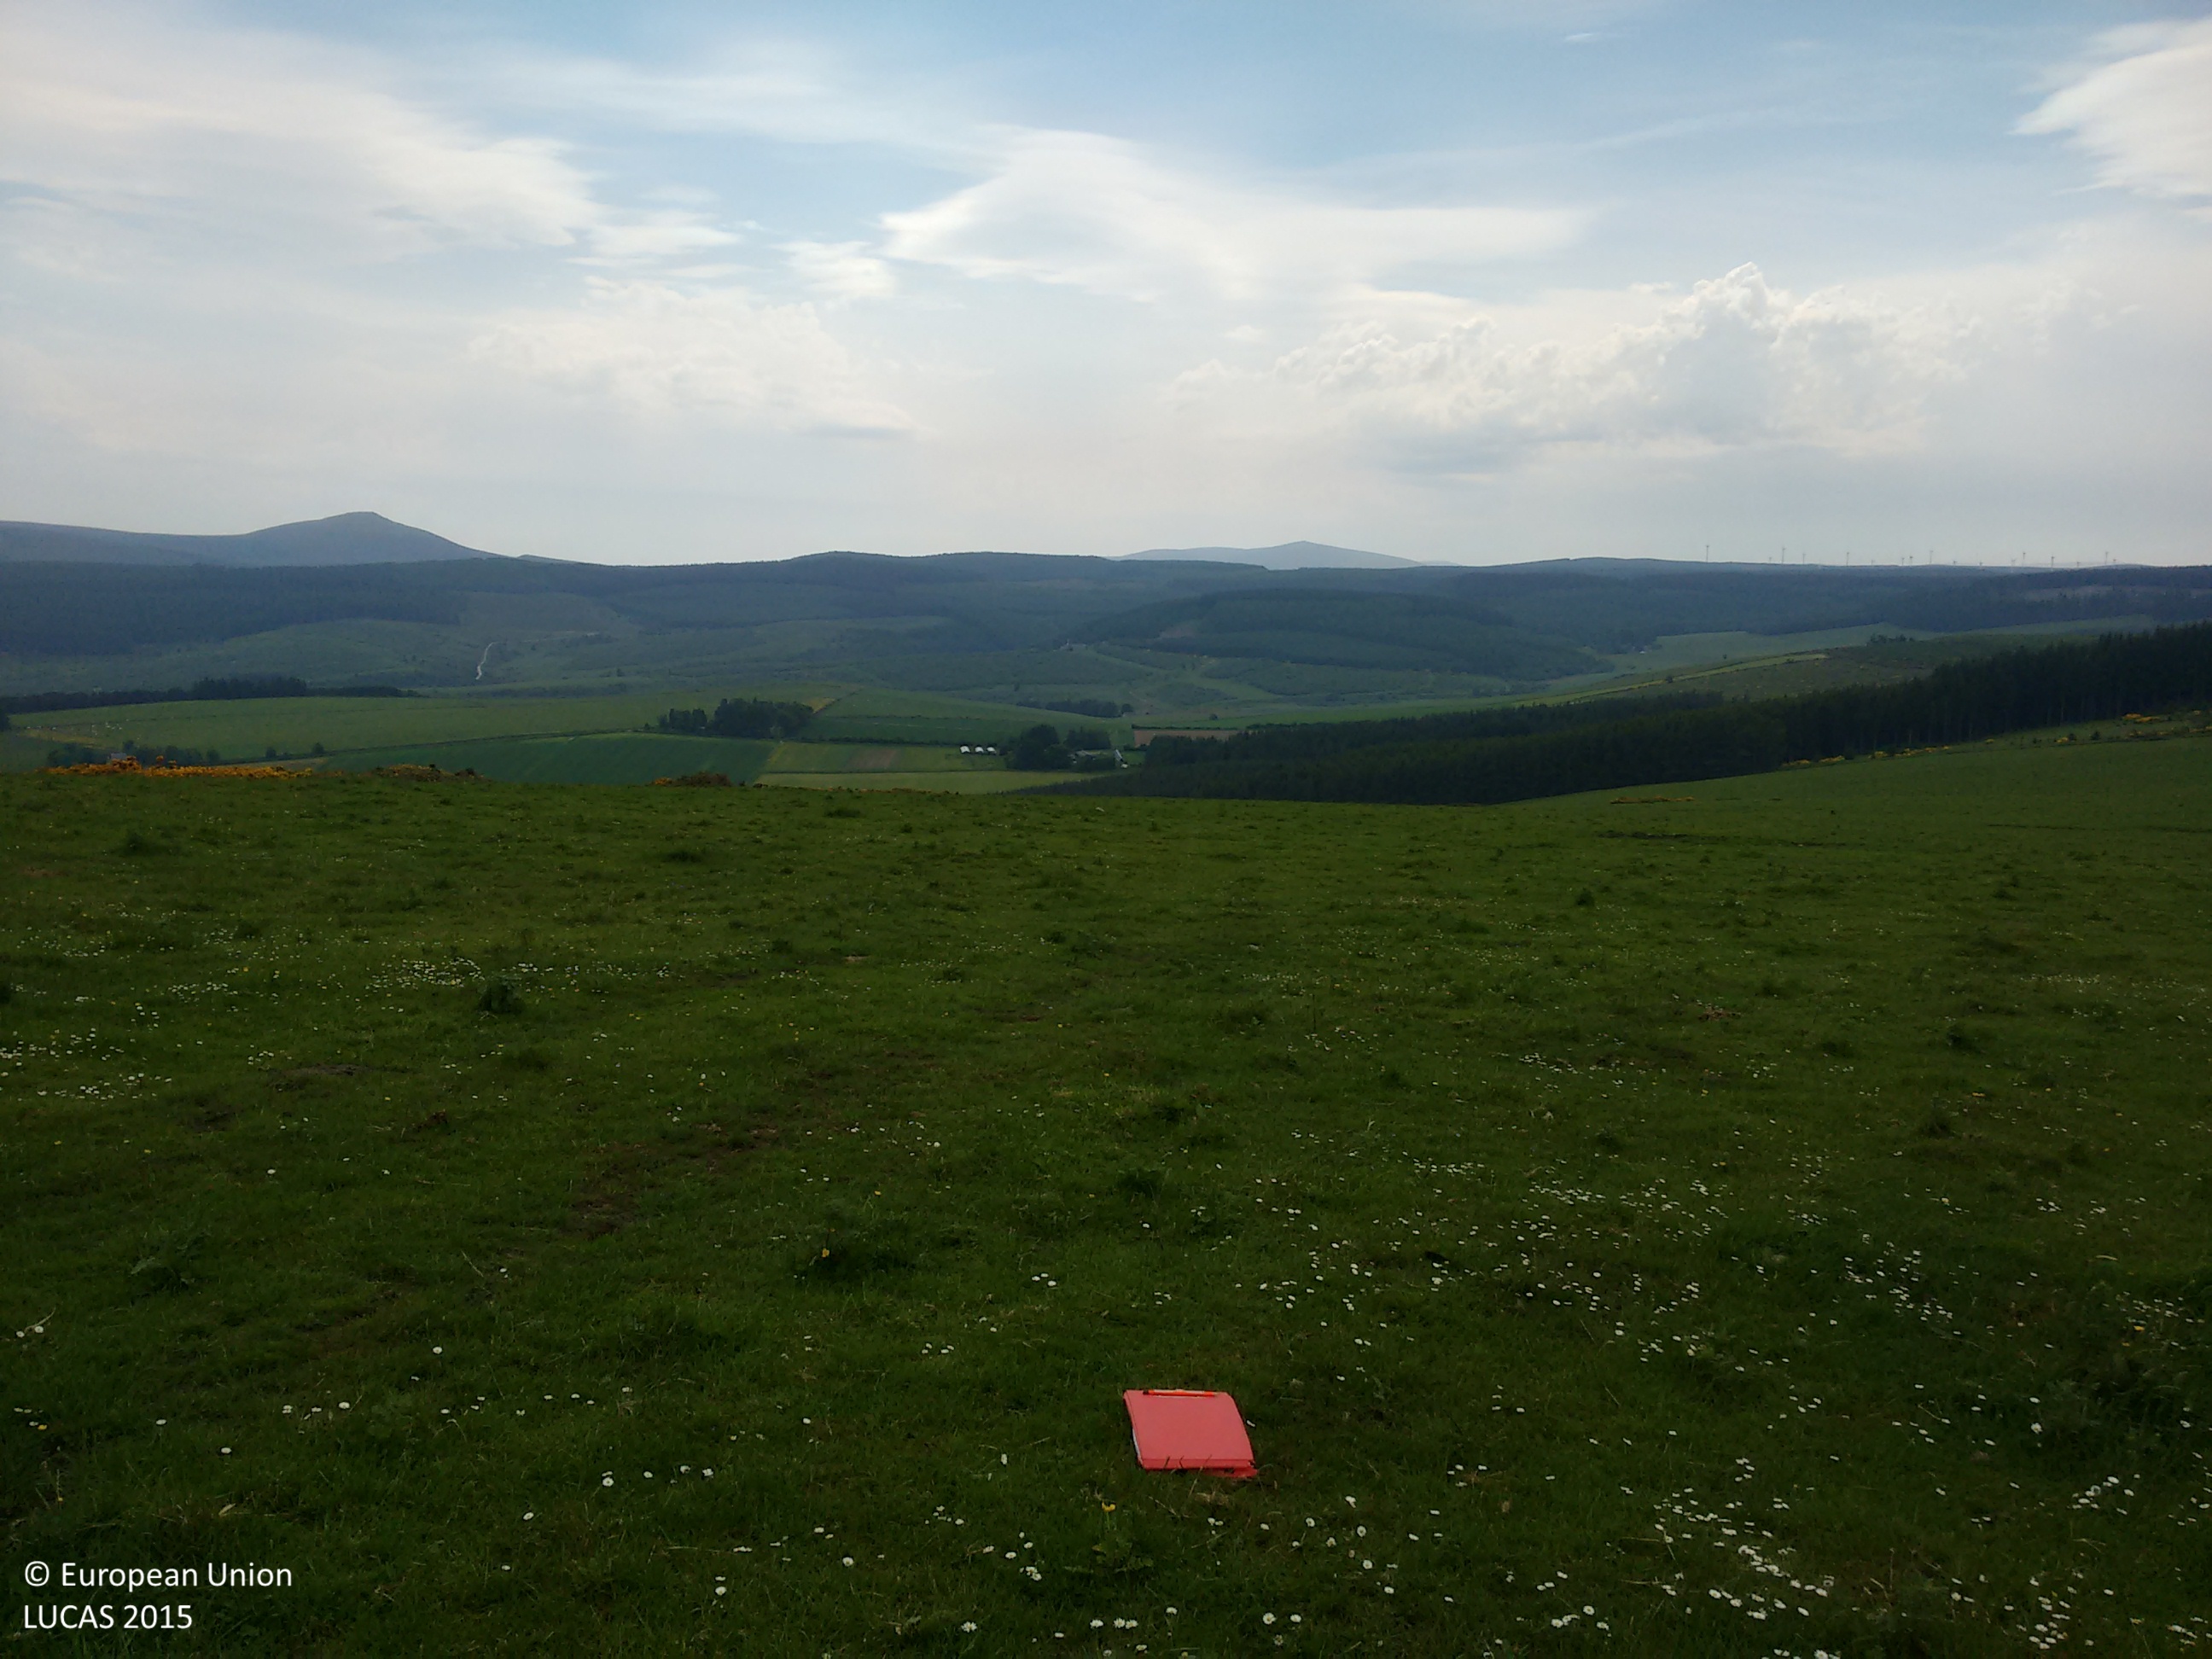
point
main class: Grassland
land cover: Grassland without tree/shrub cover
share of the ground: > 75 %
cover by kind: herbaceous plants 100 %
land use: Agriculture (excluding fallow land and kitchen gardens)
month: July
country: GB
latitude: 57.4156
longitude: -2.8621
